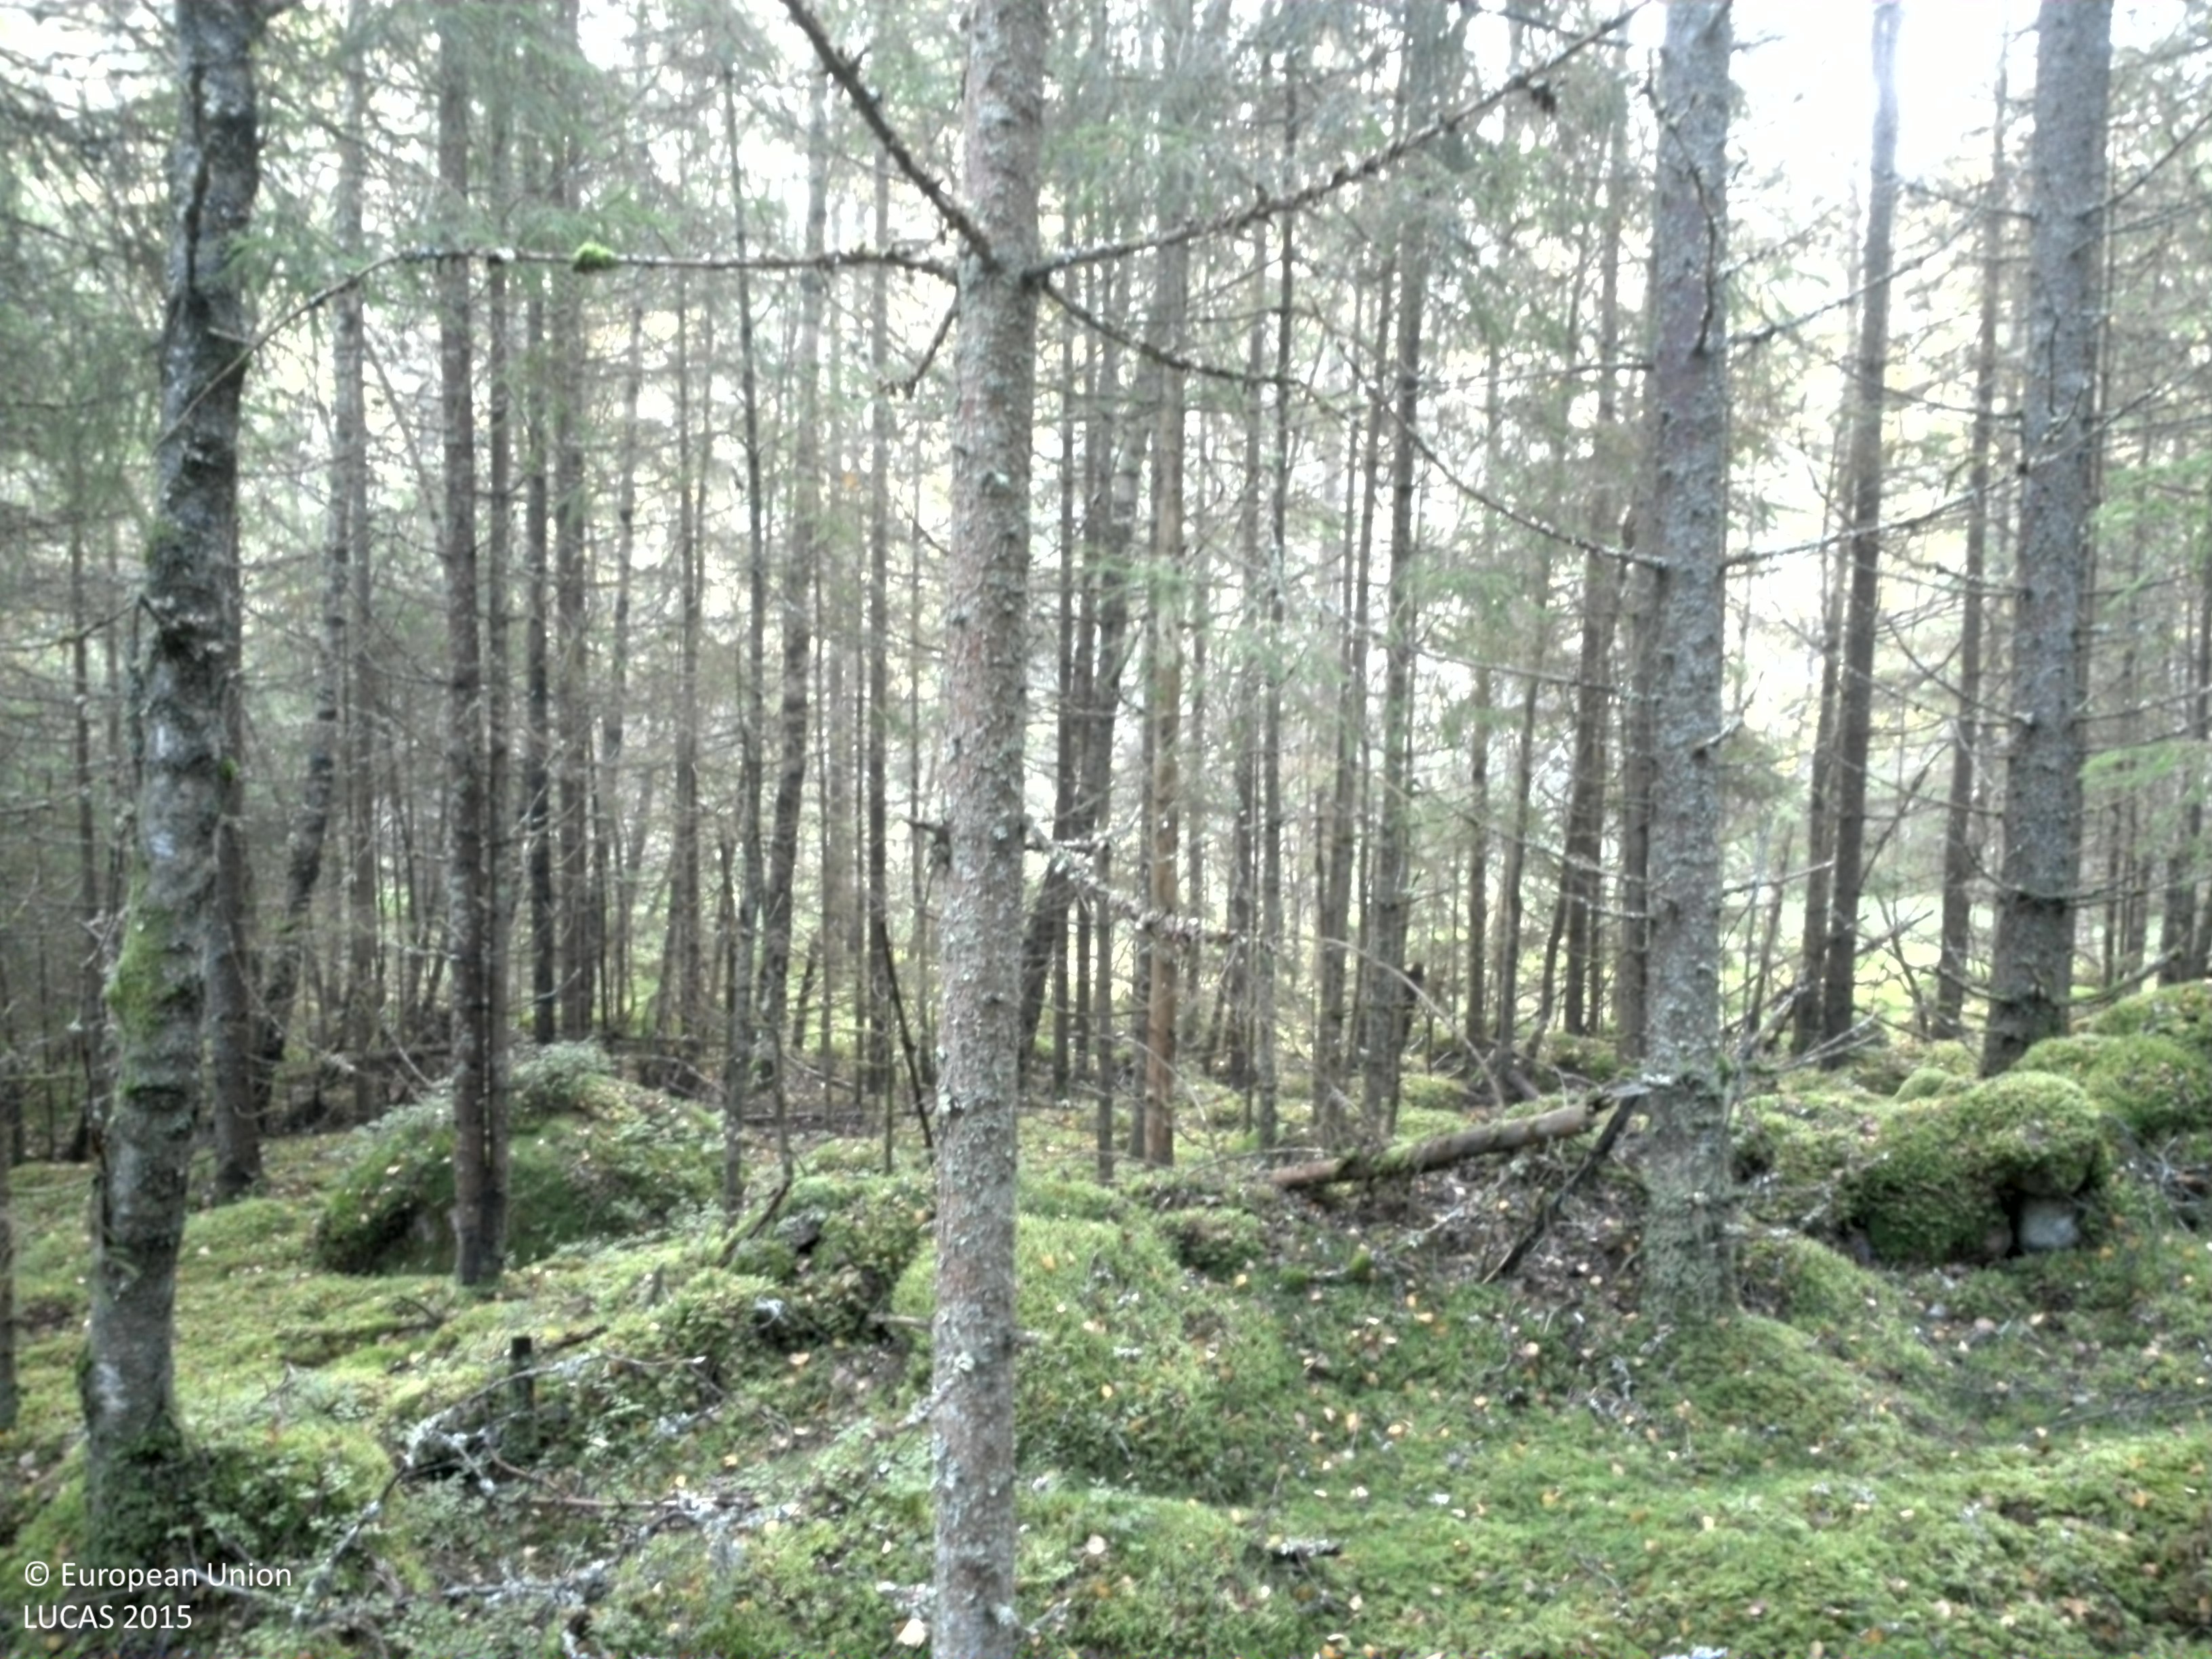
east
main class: Woodland
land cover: Spruce dominated coniferous woodland
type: boreal forest
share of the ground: > 75 %
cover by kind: coniferous forest trees 75 %, lichens and mosses 25 %
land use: Forestry
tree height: > 5 m
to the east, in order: Spruce dominated coniferous woodland; Dry stone walls; Spruce dominated coniferous woodland; Peatbogs; Spruce dominated coniferous woodland; Tracks; Spruce dominated coniferous woodland; Spruce dominated mixed woodland
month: September
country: SE
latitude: 57.8743
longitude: 13.2491
